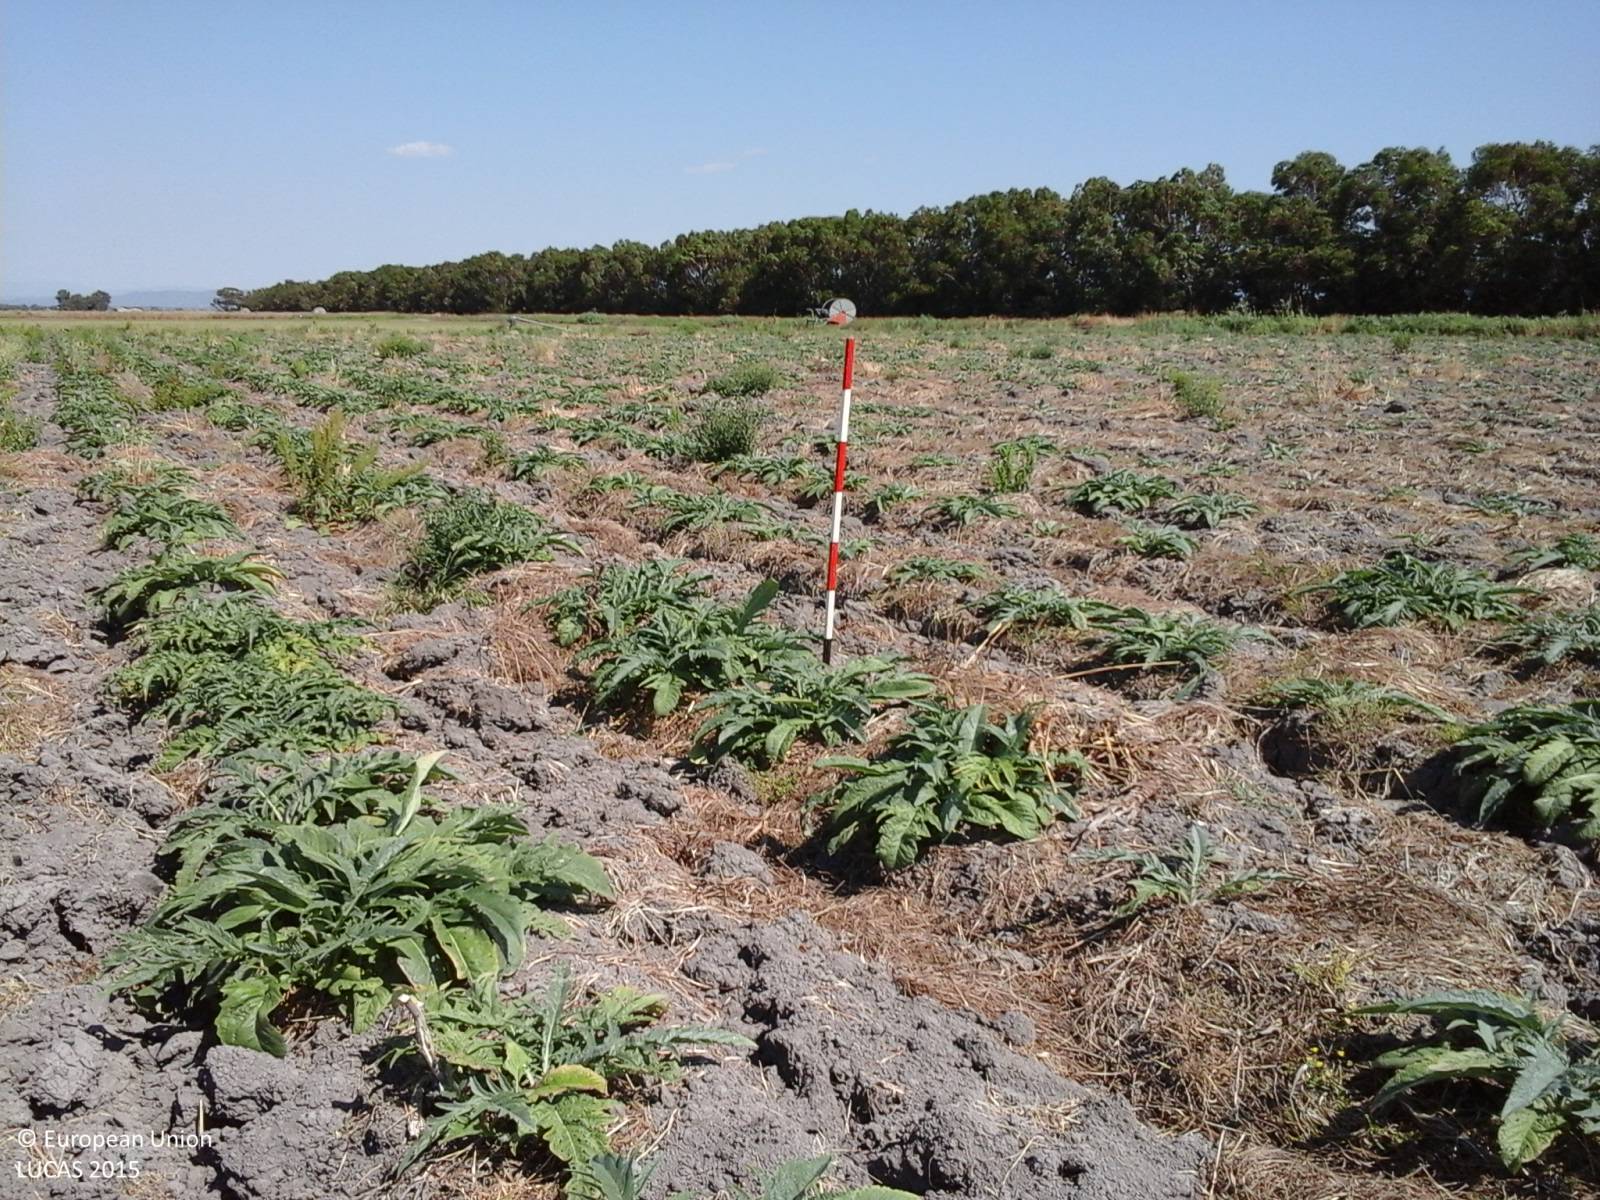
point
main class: Cropland
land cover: Other fresh vegetables
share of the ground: 50 - 75 %
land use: Agriculture (excluding fallow land and kitchen gardens)
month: July
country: IT
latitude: 40.0030
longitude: 8.5437
